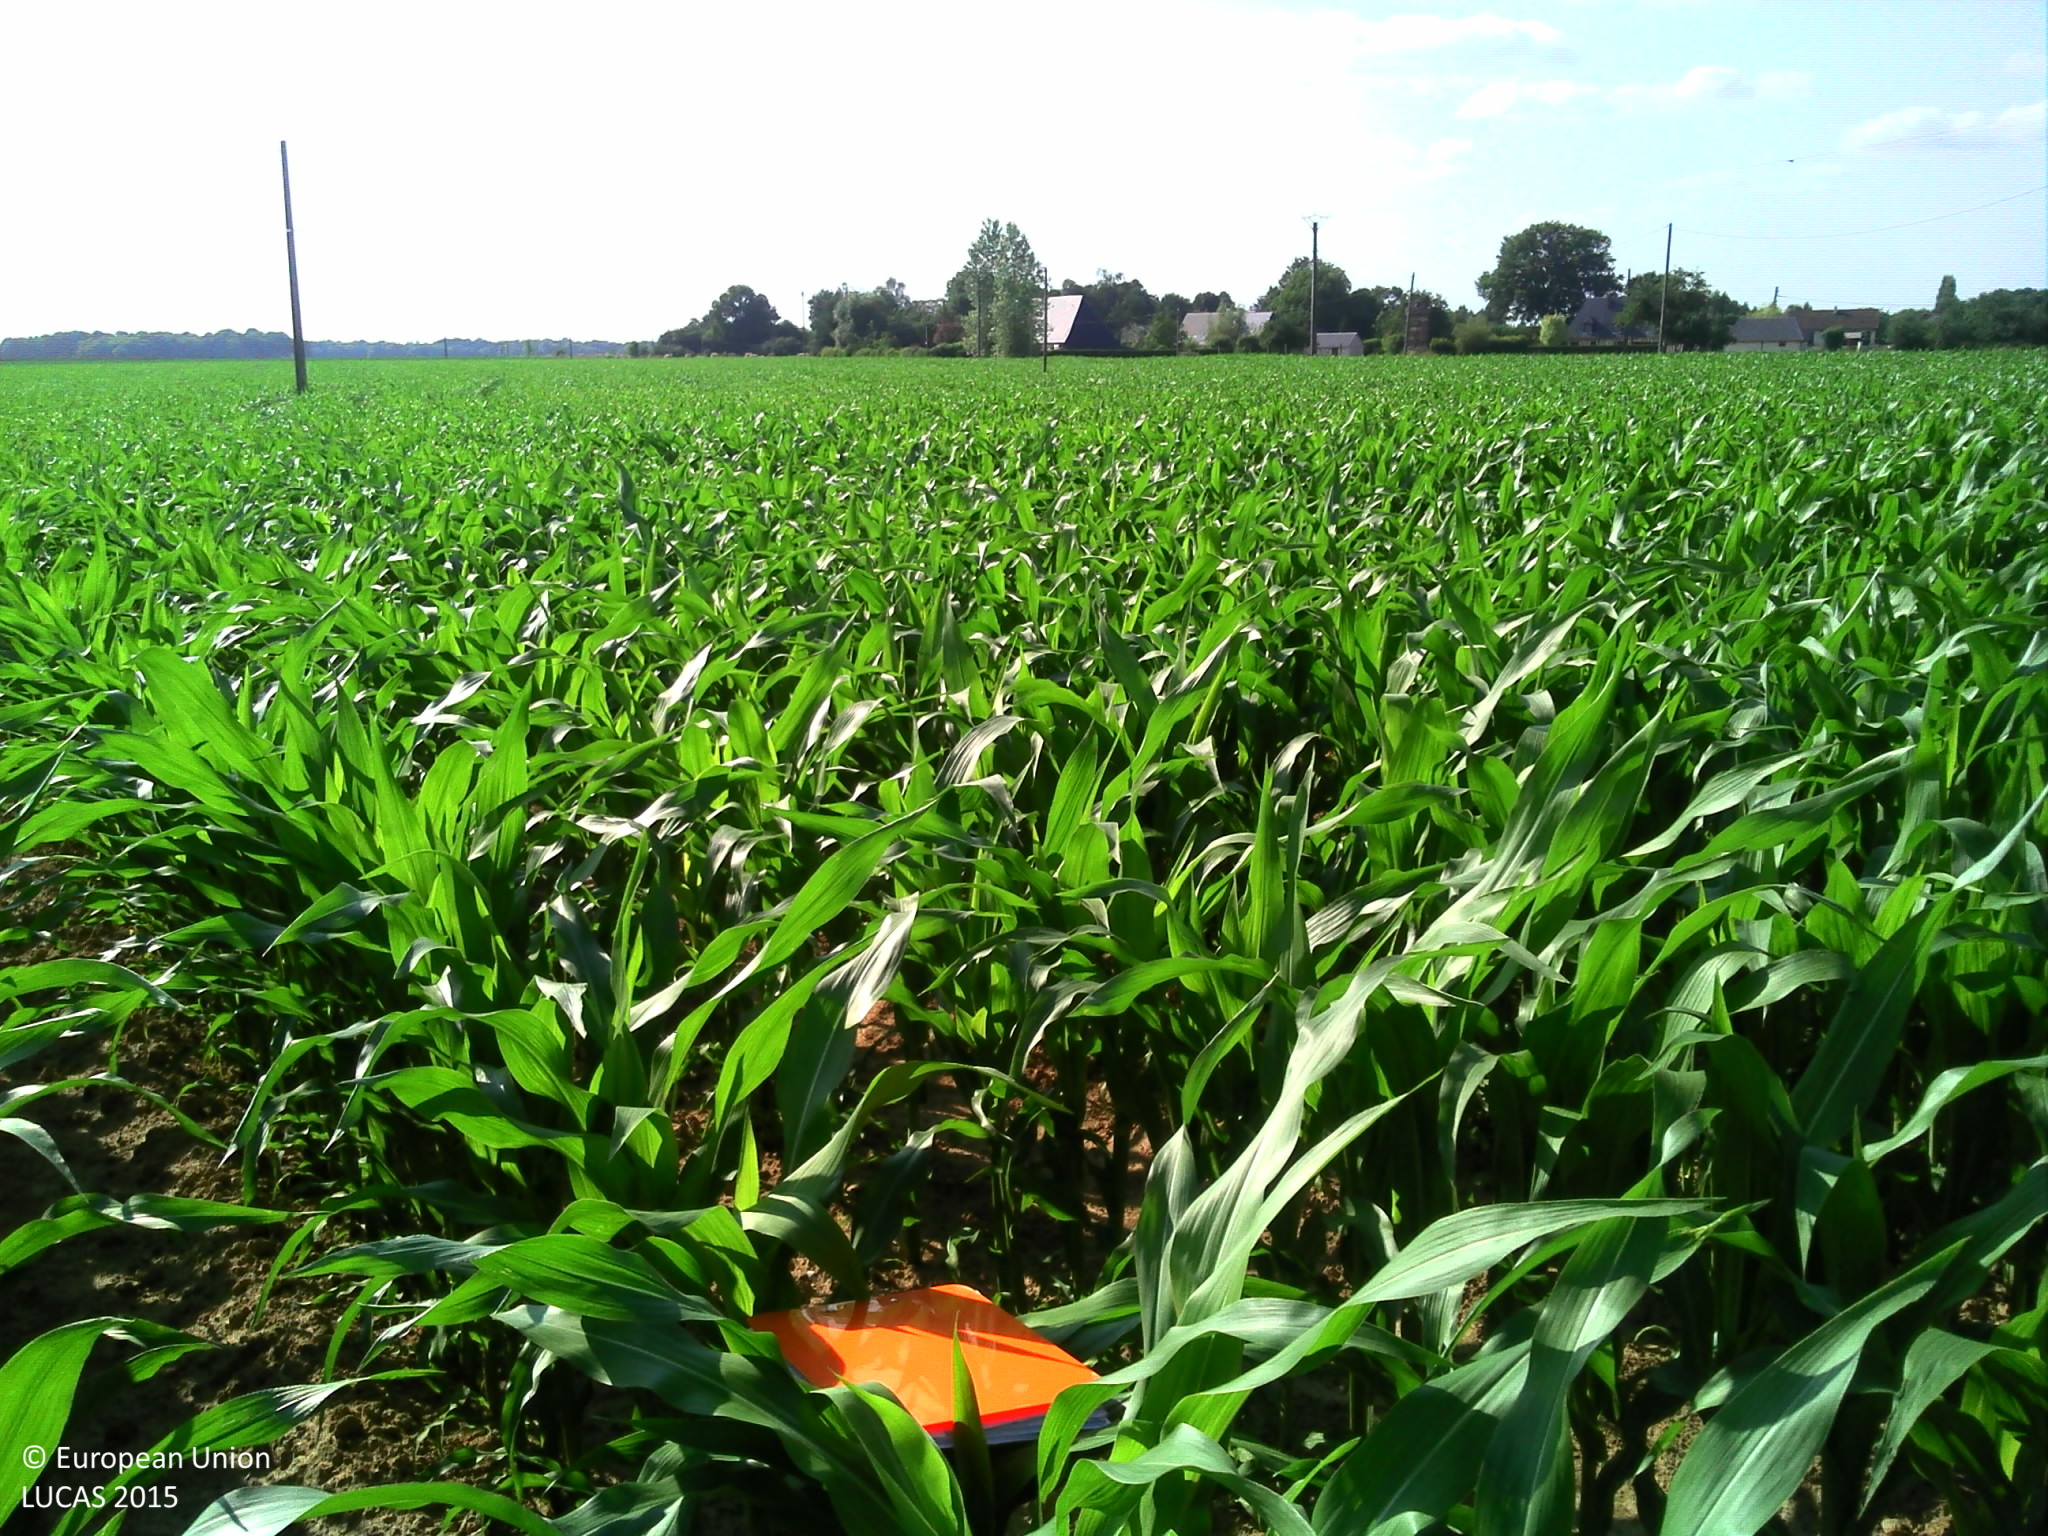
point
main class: Cropland
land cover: Maize
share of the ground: > 75 %
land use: Agriculture (excluding fallow land and kitchen gardens)
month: July
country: FR
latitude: 49.1689
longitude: 0.6902
